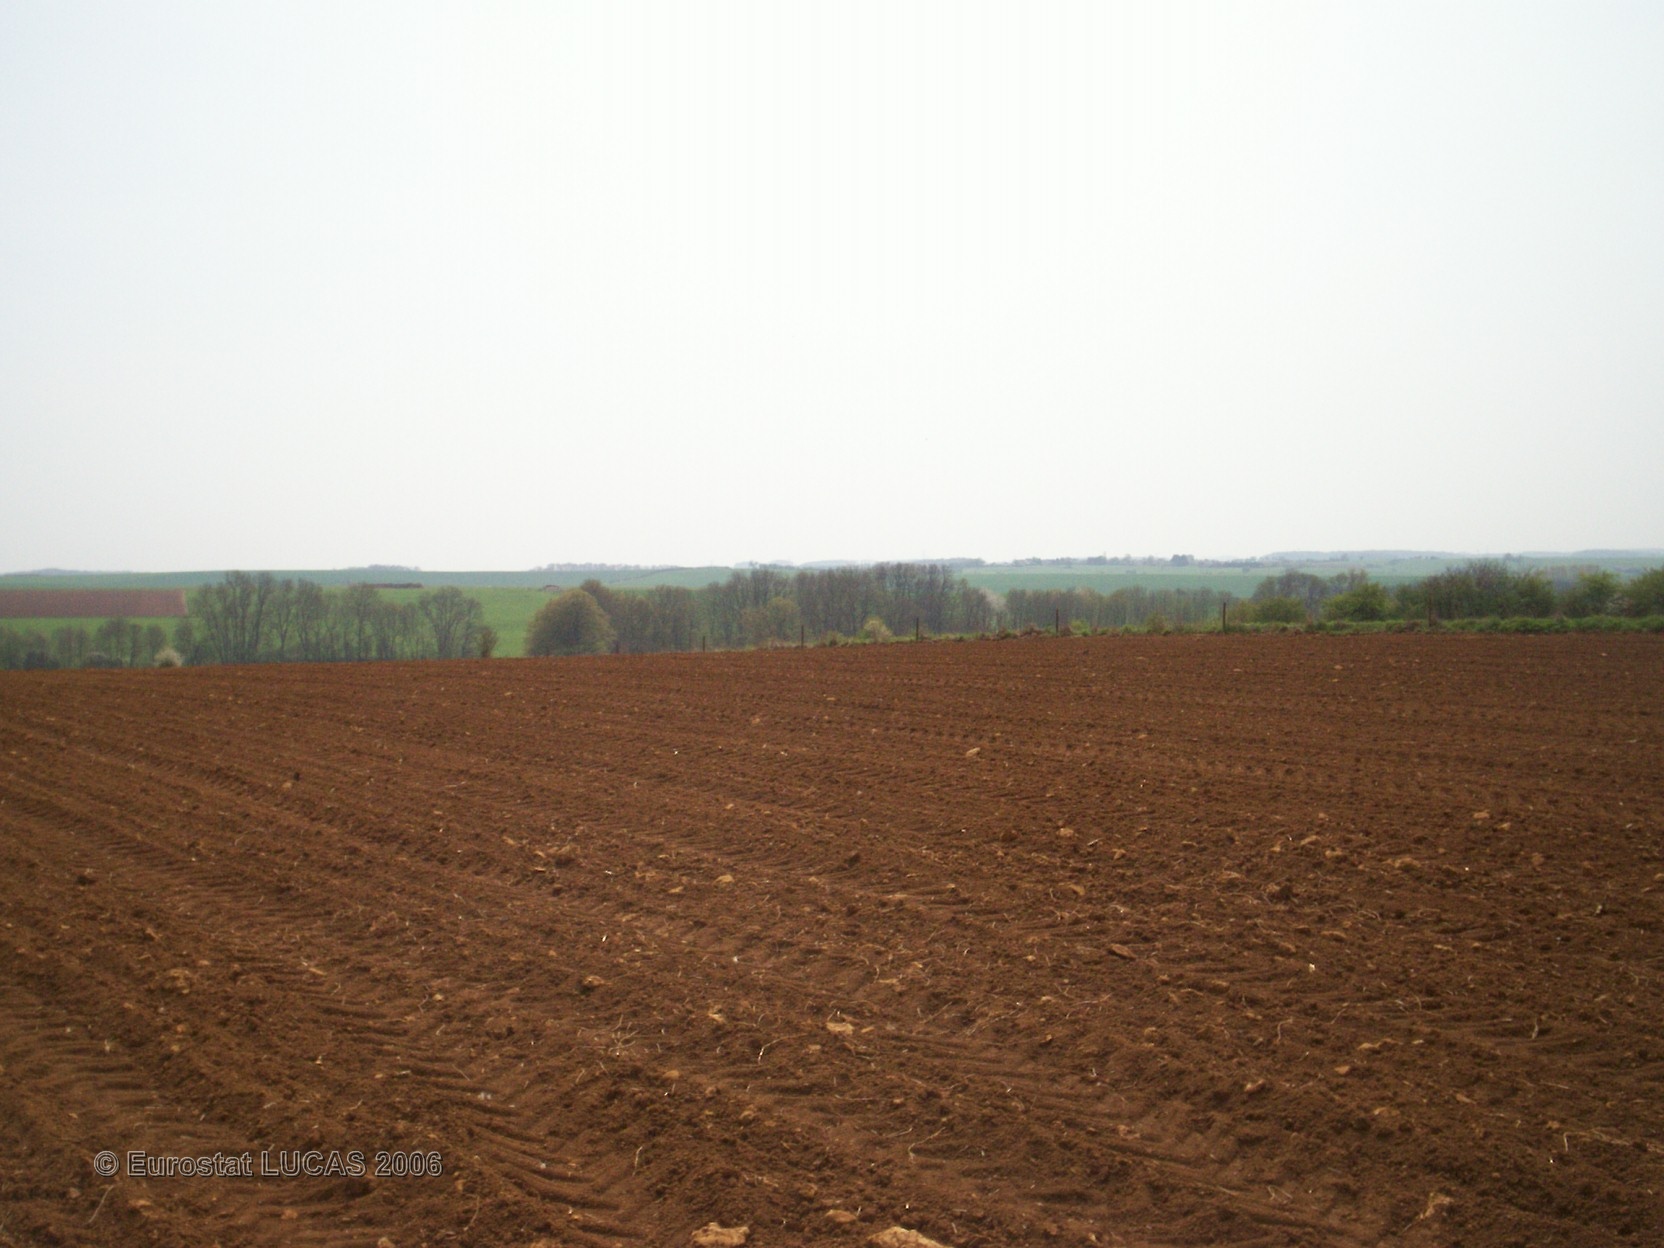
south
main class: Cropland
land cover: Maize
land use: Agriculture (excluding fallow land and kitchen gardens)
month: May
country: FR
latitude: 49.8631
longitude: 4.3336
